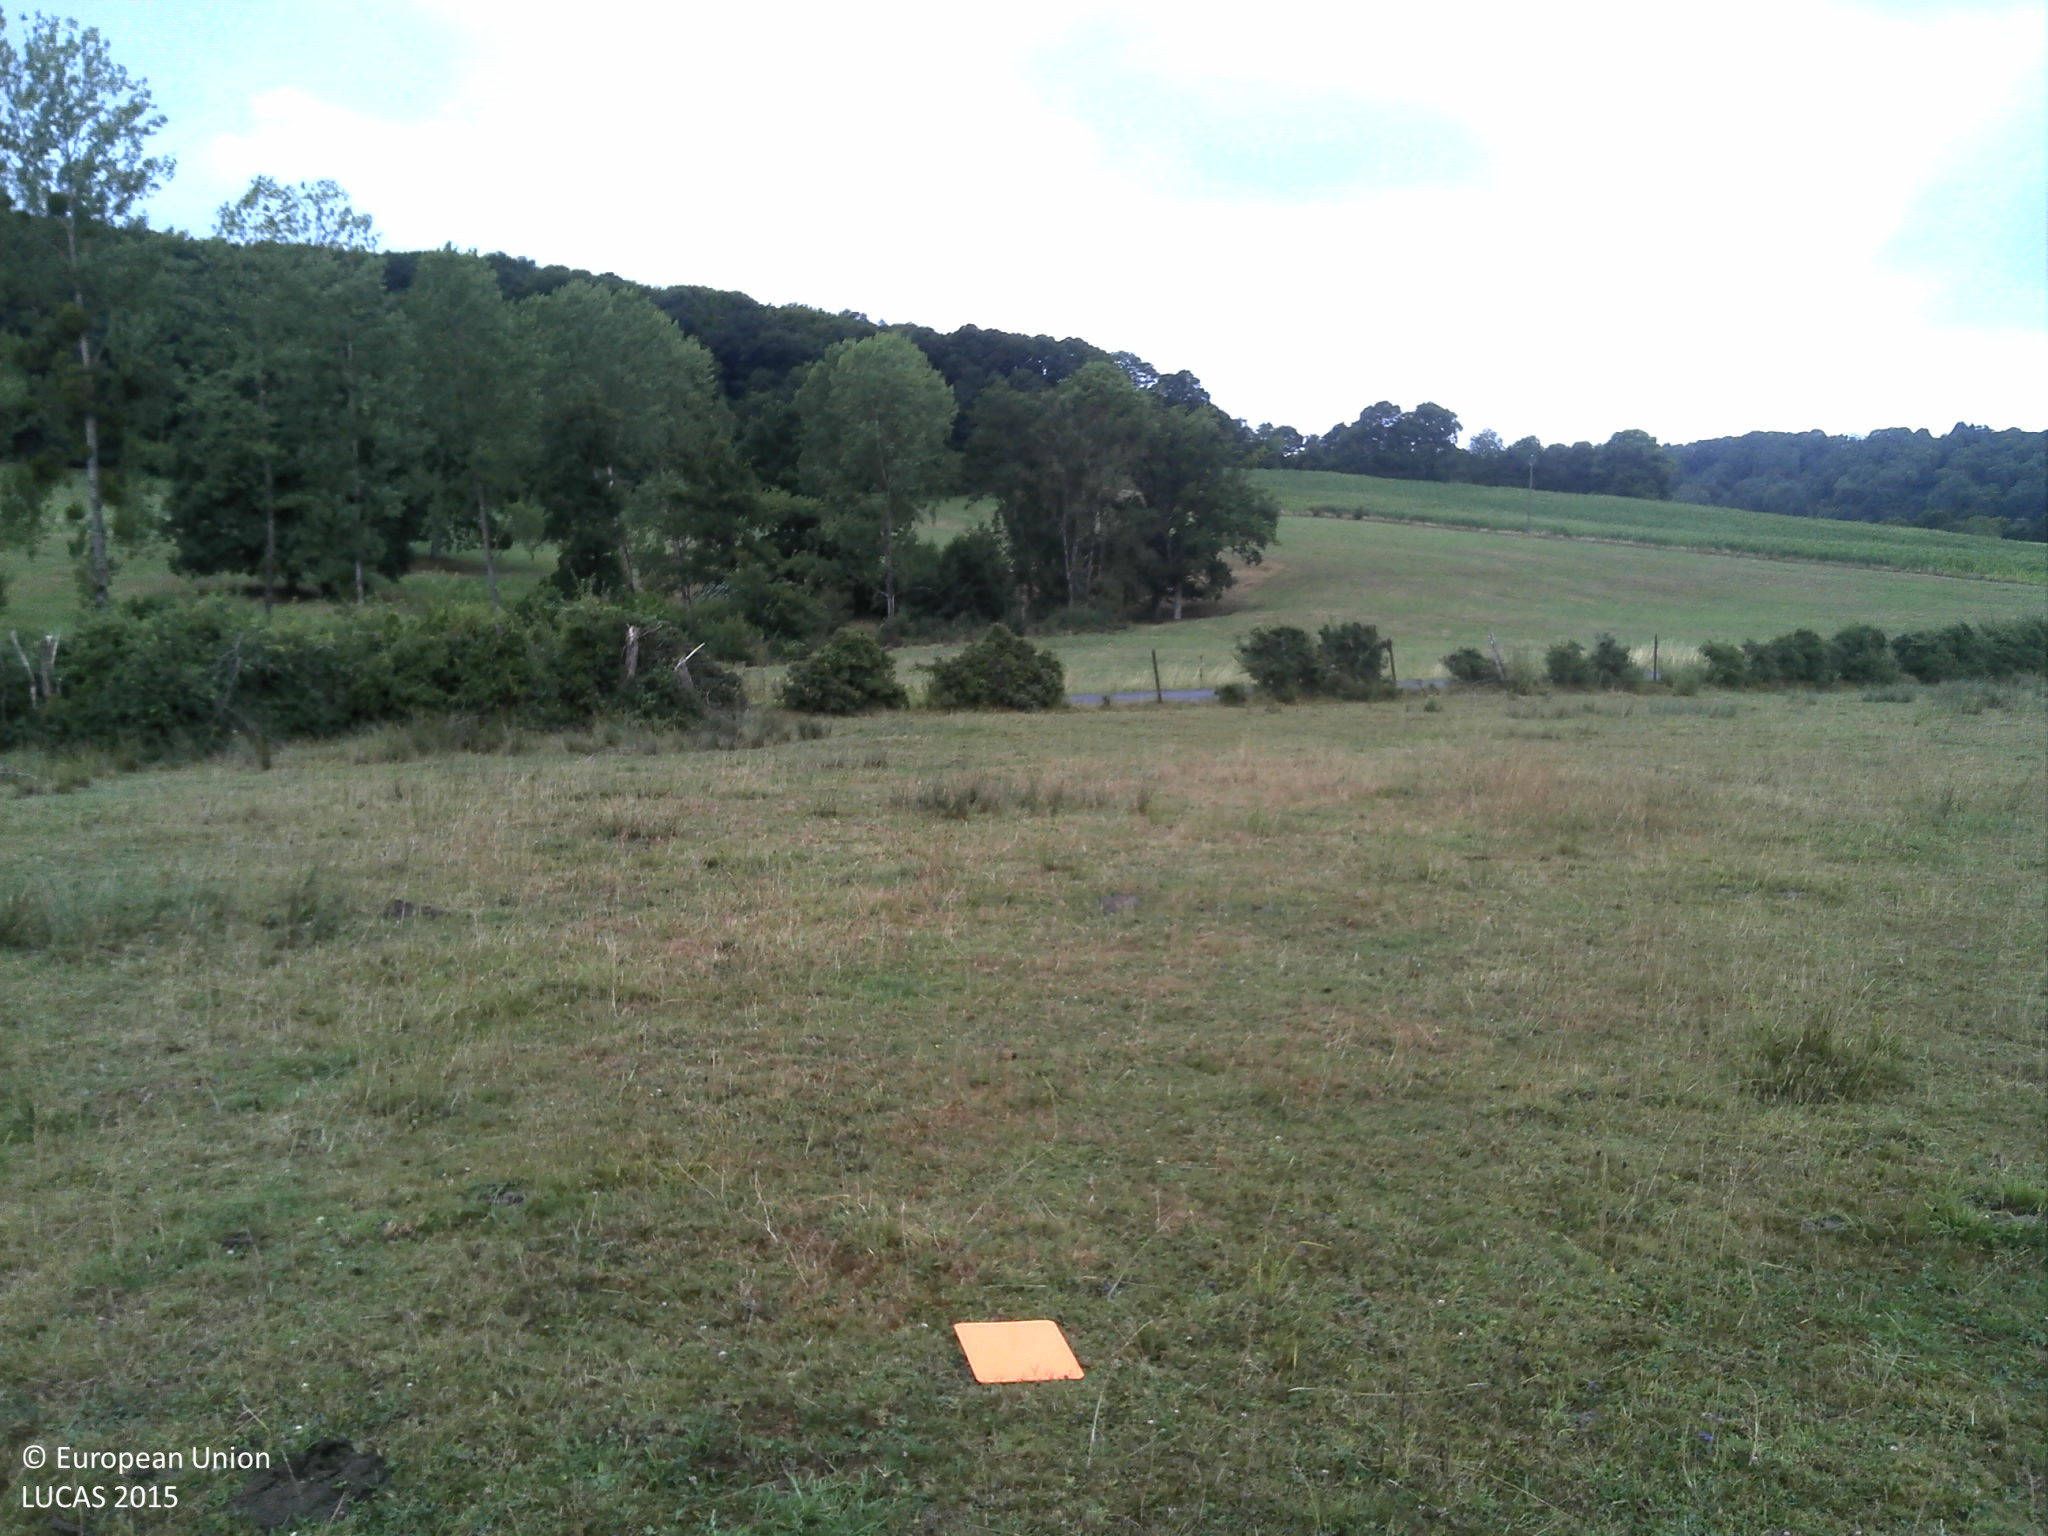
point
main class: Grassland
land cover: Grassland without tree/shrub cover
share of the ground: > 75 %
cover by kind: herbaceous plants 100 %
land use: Agriculture (excluding fallow land and kitchen gardens)
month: July
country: FR
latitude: 49.4335
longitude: 4.7709
